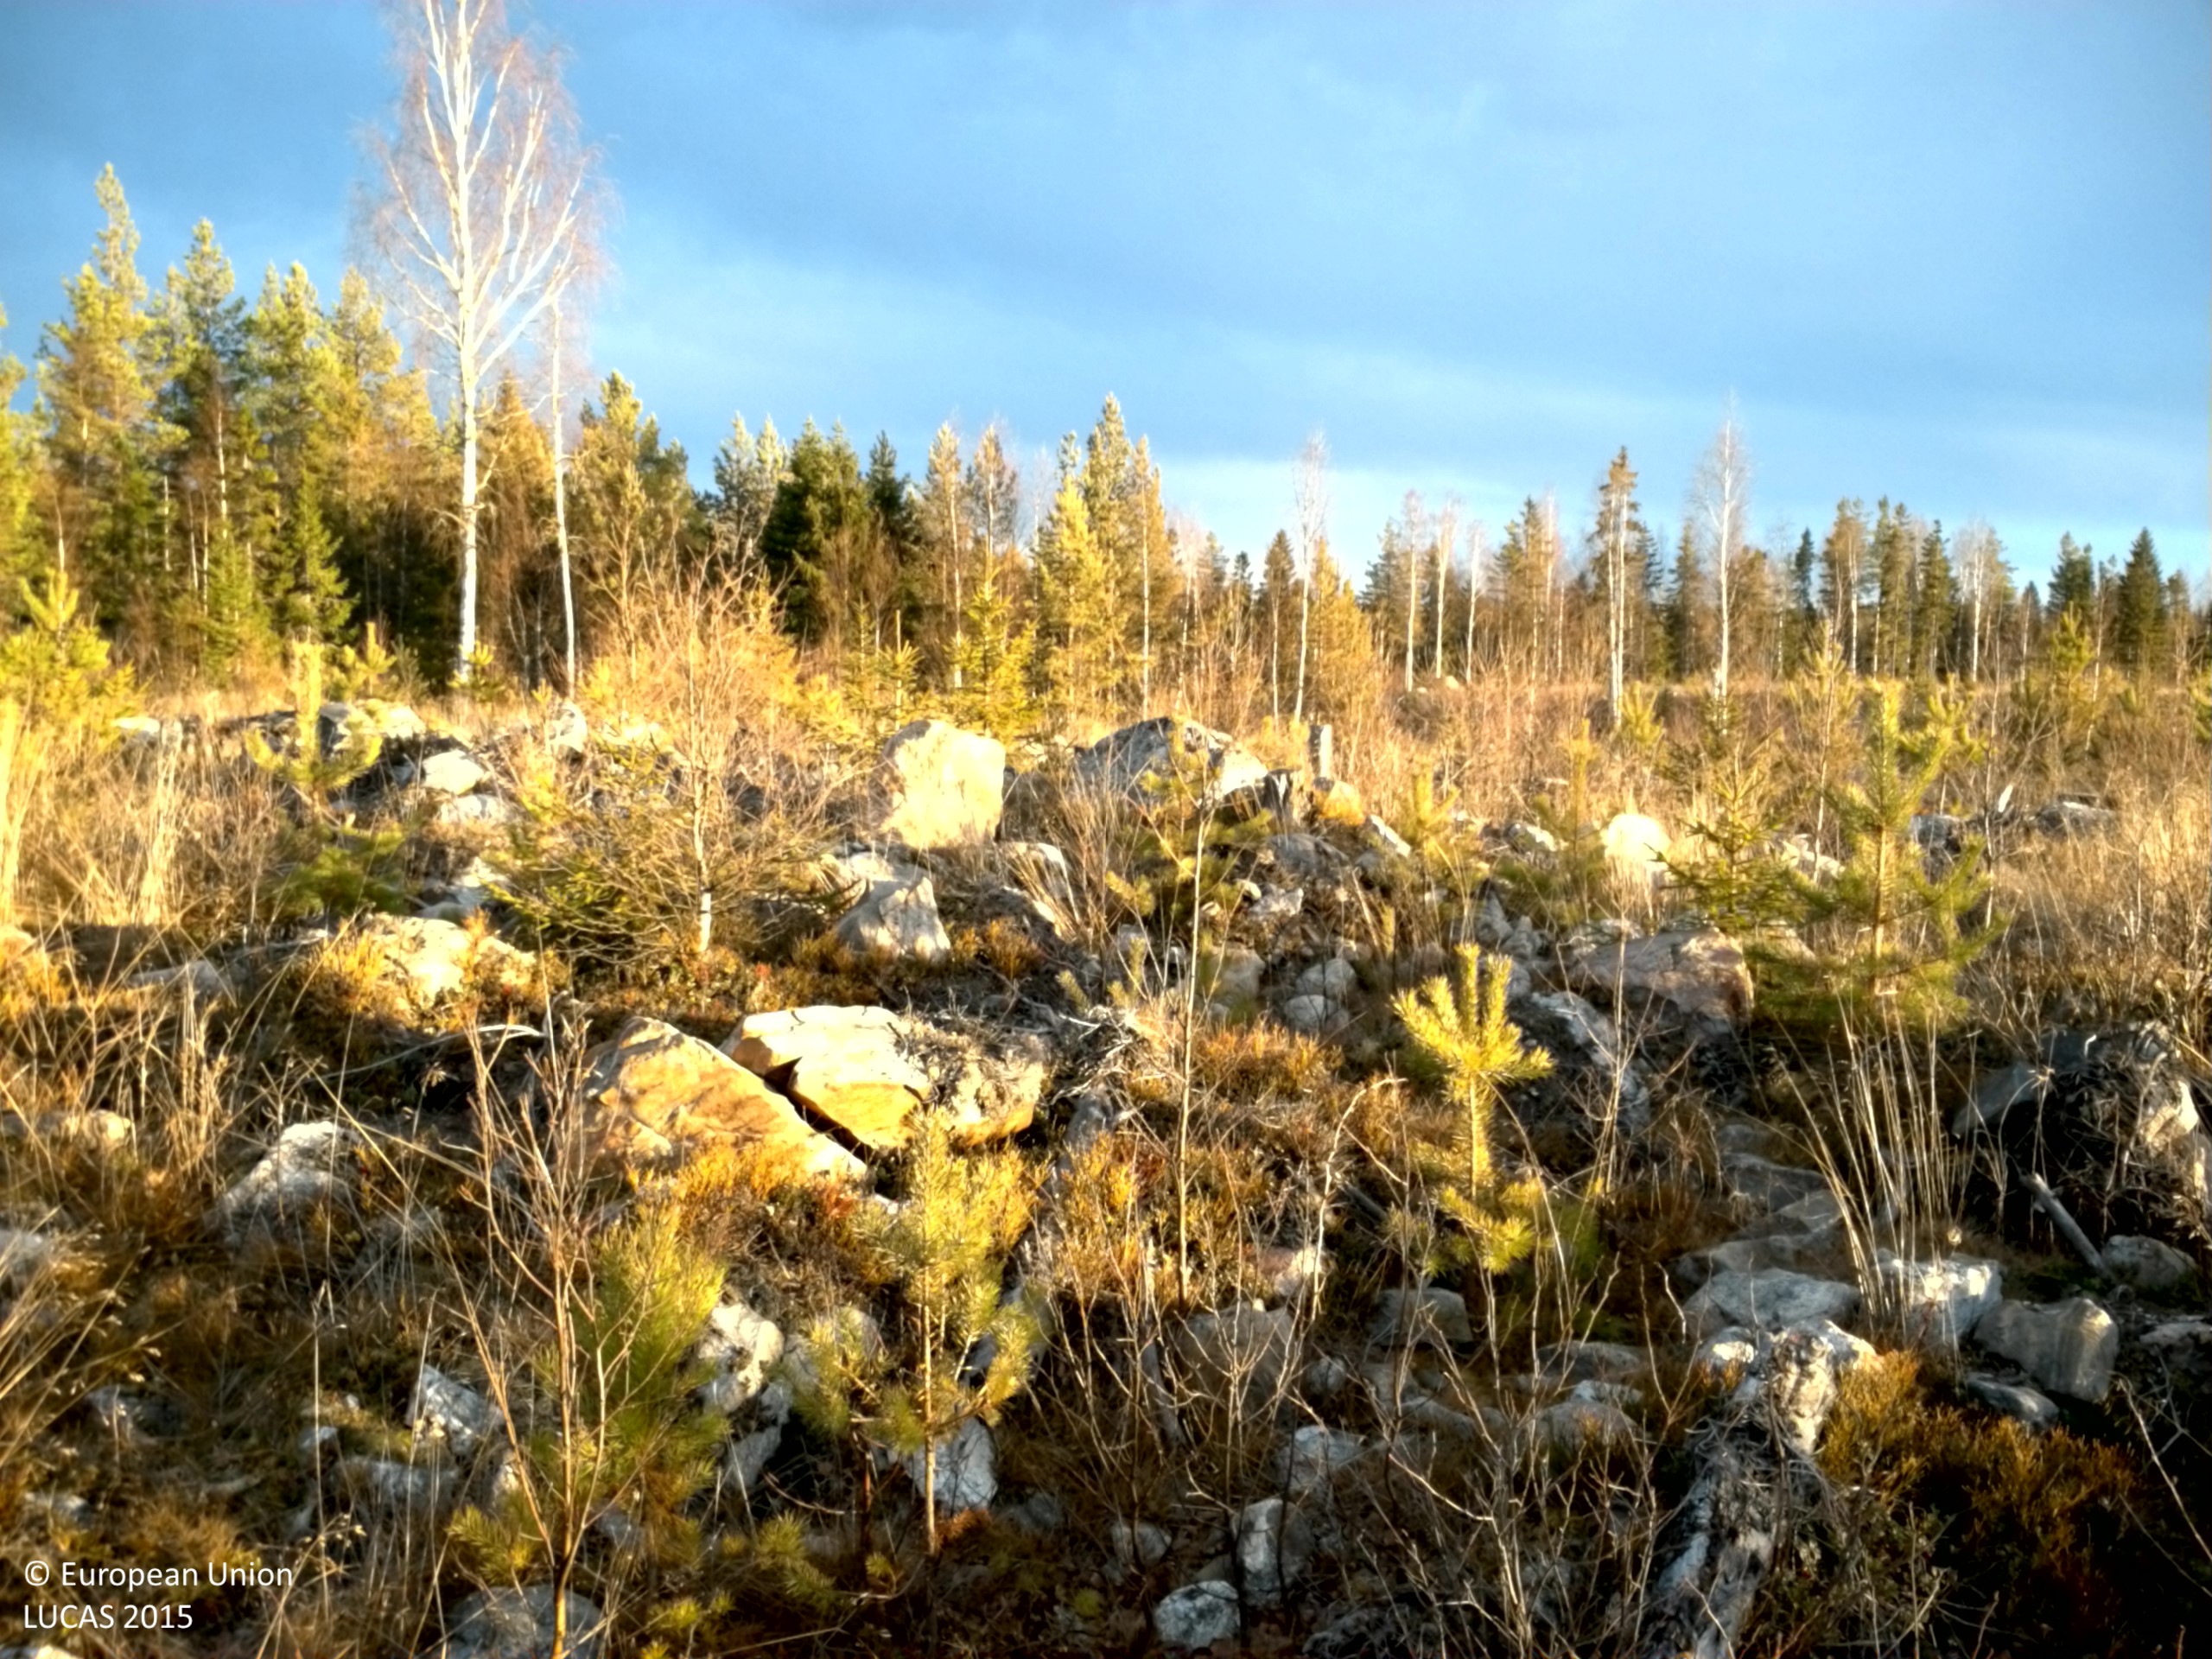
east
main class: Woodland
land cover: Pine dominated mixed woodland
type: boreal forest
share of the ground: 10 - 25 %
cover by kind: shrubs 35 %, herbaceous plants 20 %, coniferous forest trees 15 %, consolidated bare surface 15 %, lichens and mosses 10 %, broadleaved forest trees 5 %
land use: Forestry
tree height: < 5 m
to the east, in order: Pine dominated mixed woodland; Other mixed woodland; Paved roads, cycling and walking lanes; Grass margins; Spruce dominated mixed woodland; Other mixed woodland; Broadleaved woodland; Spruce dominated coniferous woodland; Pine dominated coniferous woodland
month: December
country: SE
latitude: 61.0249
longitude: 16.8894
